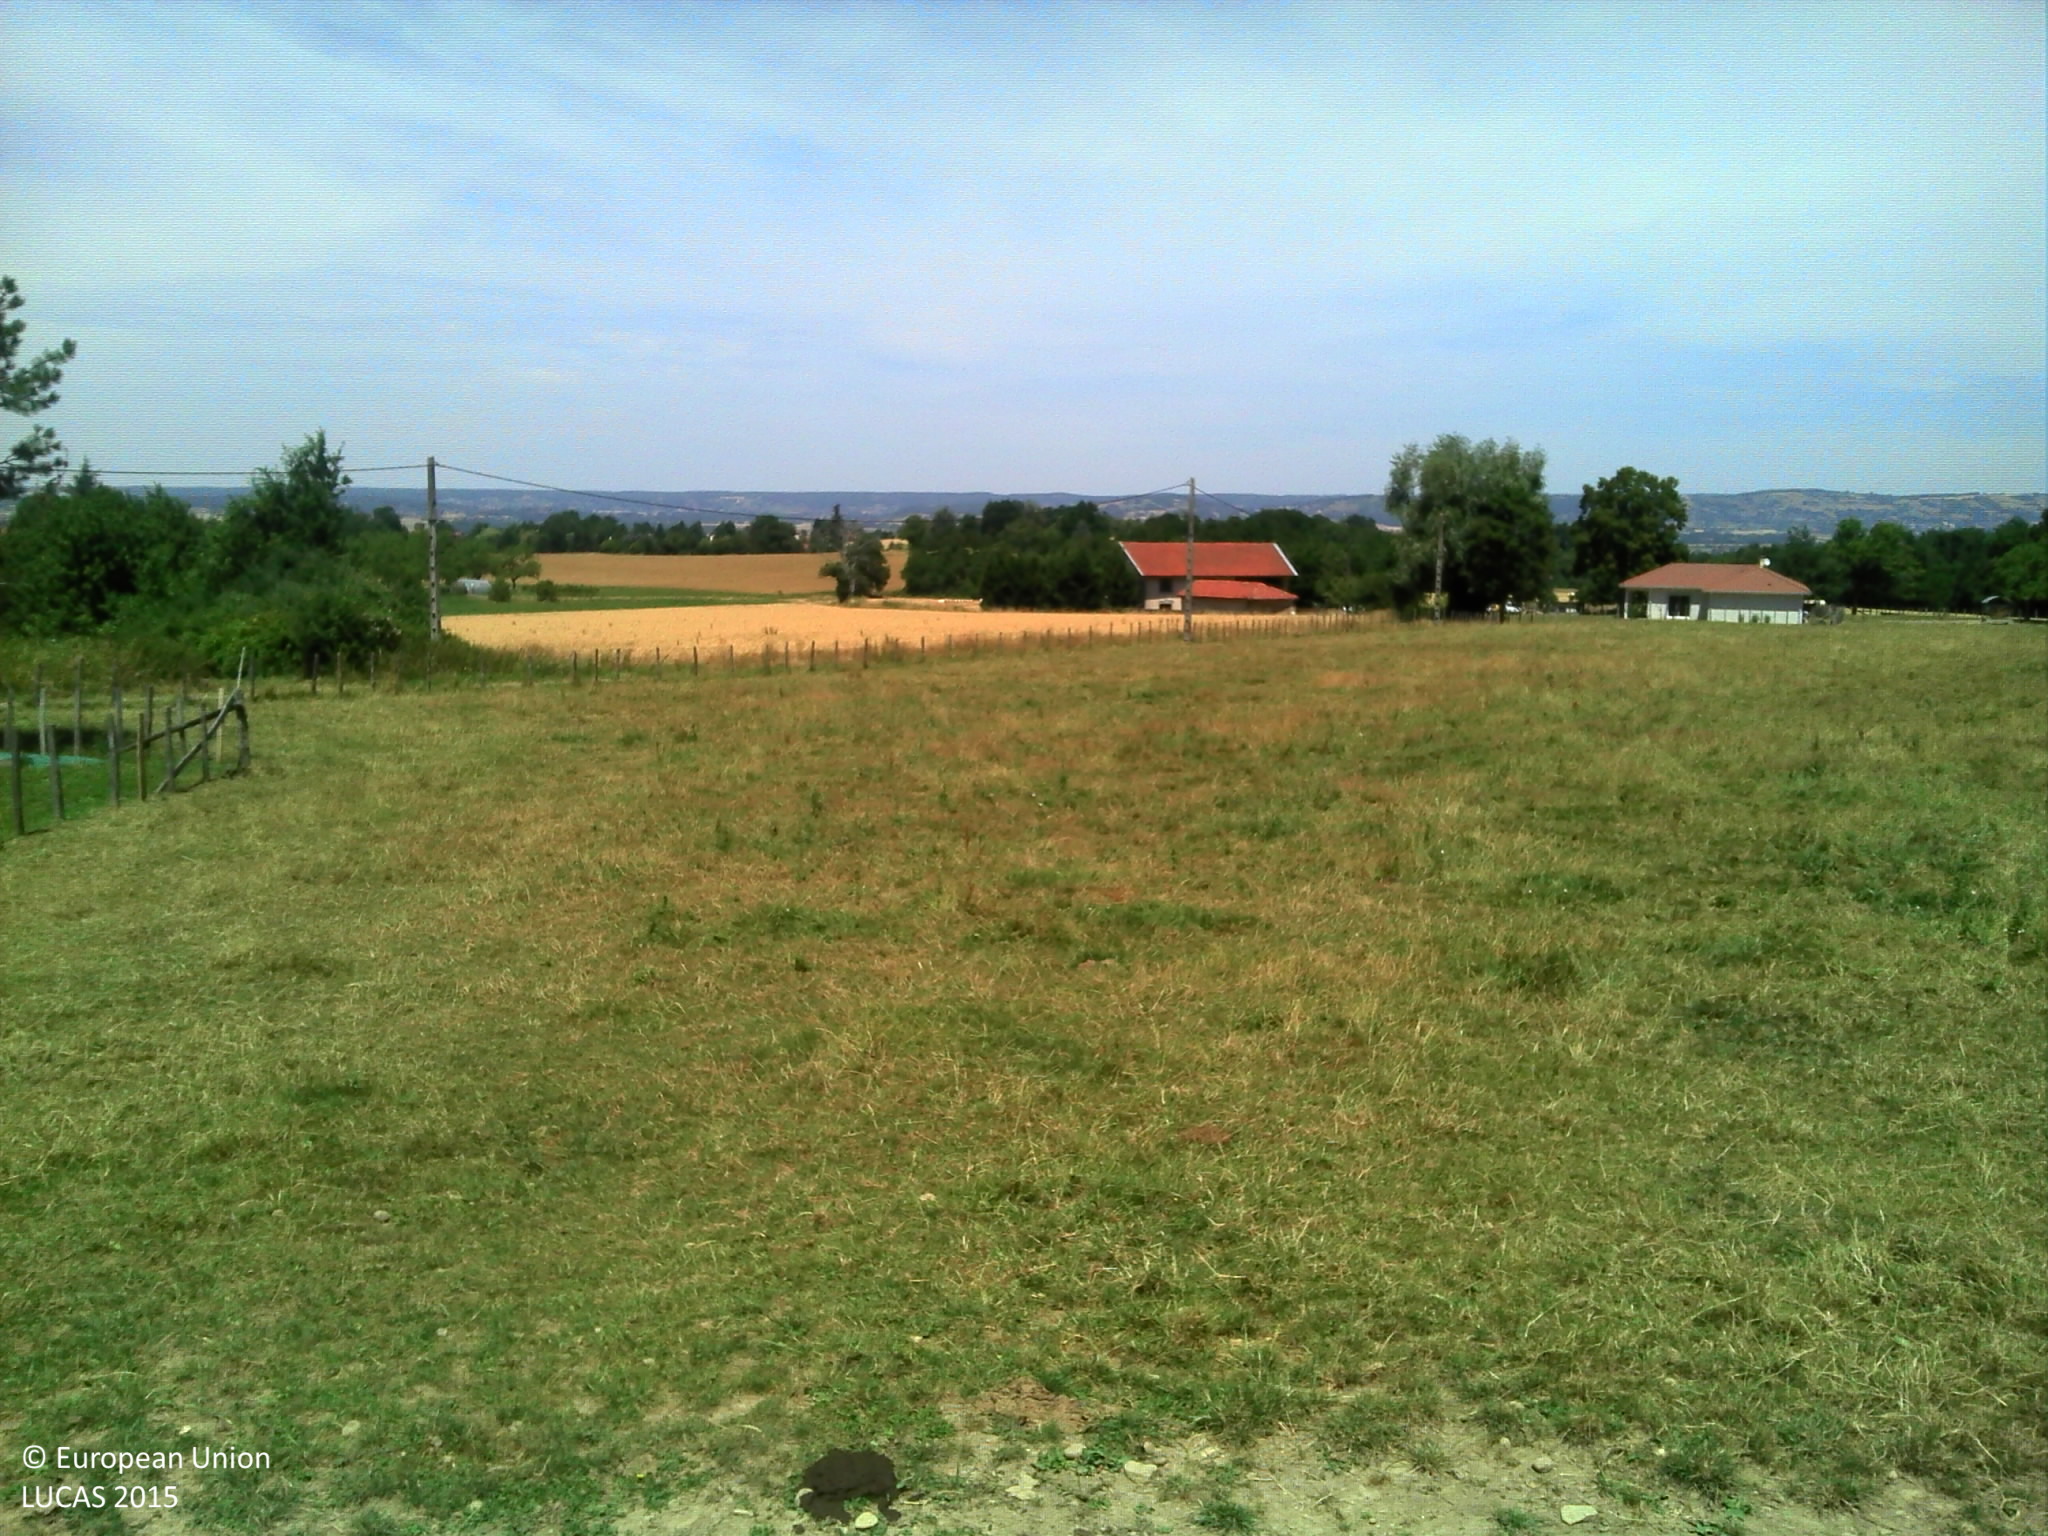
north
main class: Grassland
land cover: Grassland with sparse tree/shrub cover
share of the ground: > 75 %
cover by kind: herbaceous plants 90 %, broadleaved forest trees 5 %, consolidated bare surface 5 %
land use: Agriculture (excluding fallow land and kitchen gardens)
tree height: > 5 m
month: July
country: FR
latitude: 45.3049
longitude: 5.1968
